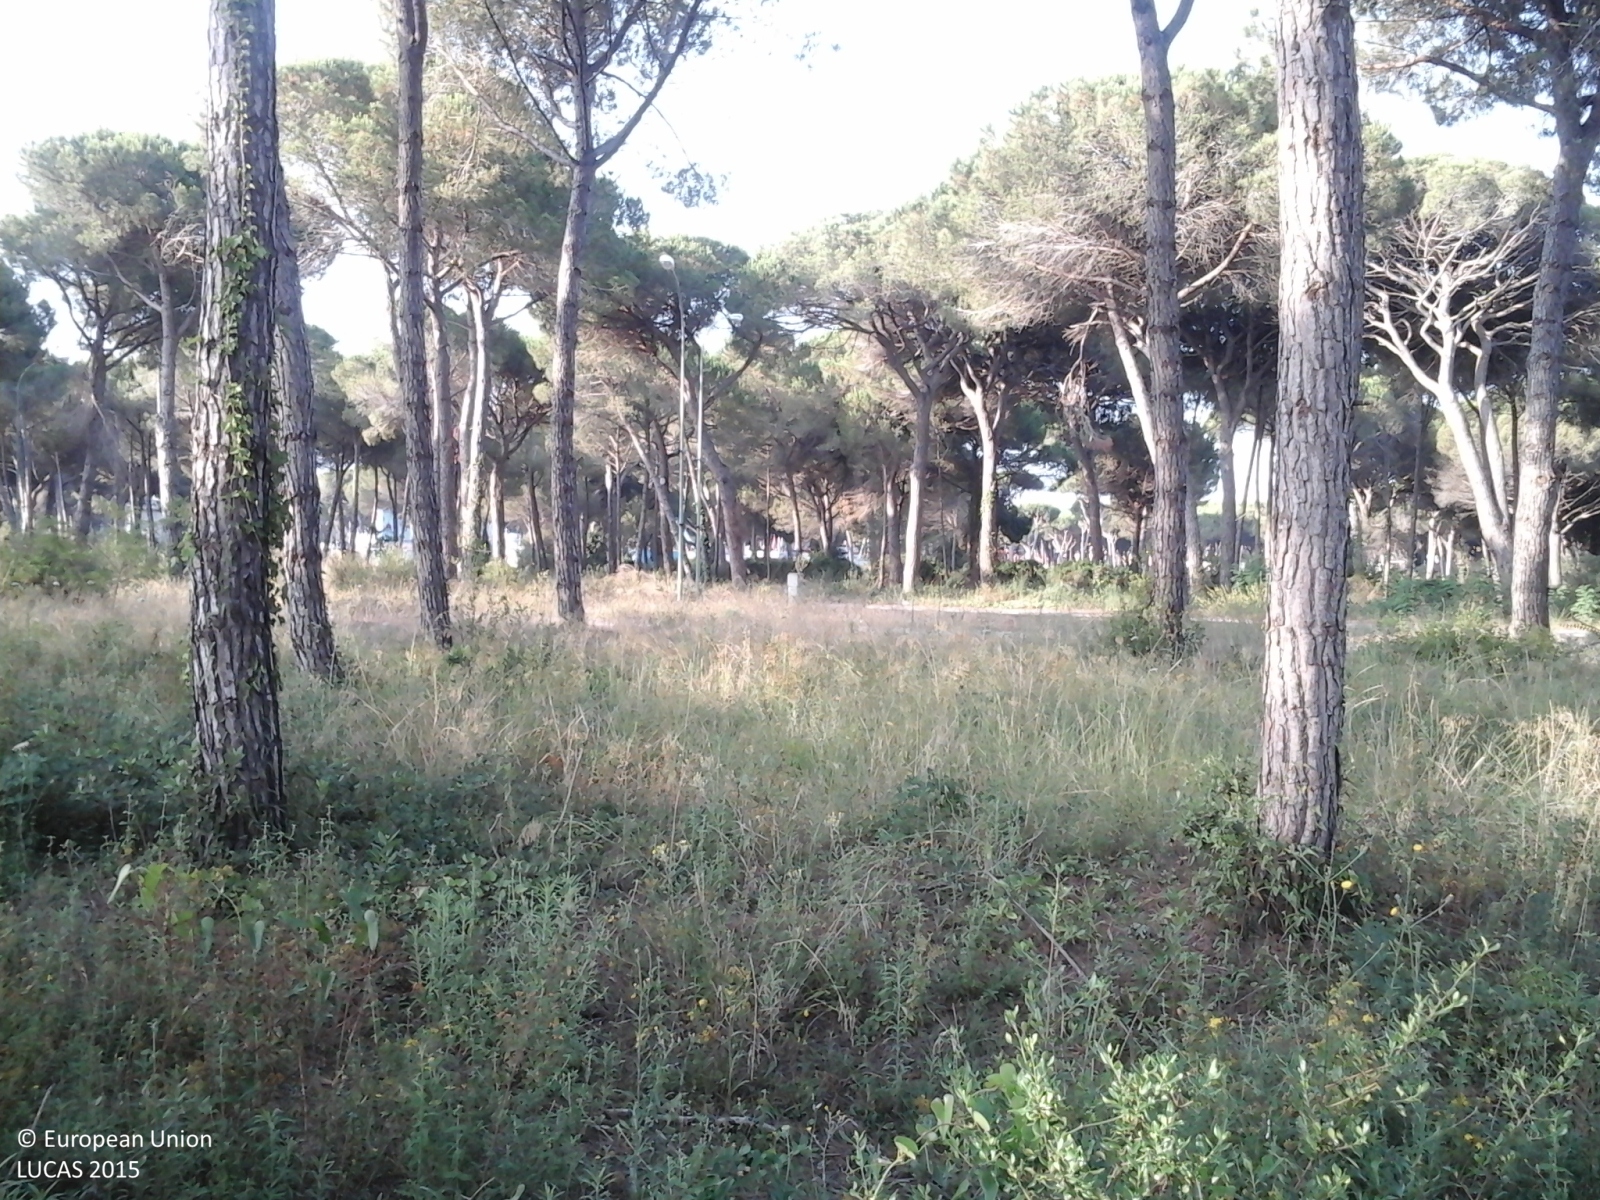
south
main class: Woodland
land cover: Pine dominated coniferous woodland
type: broadleaved evergreen forest
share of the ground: > 75 %
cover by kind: coniferous forest trees 80 %, shrubs 10 %, herbaceous plants 10 %
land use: Forestry
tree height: > 5 m
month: July
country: IT
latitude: 42.7215
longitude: 10.9859
